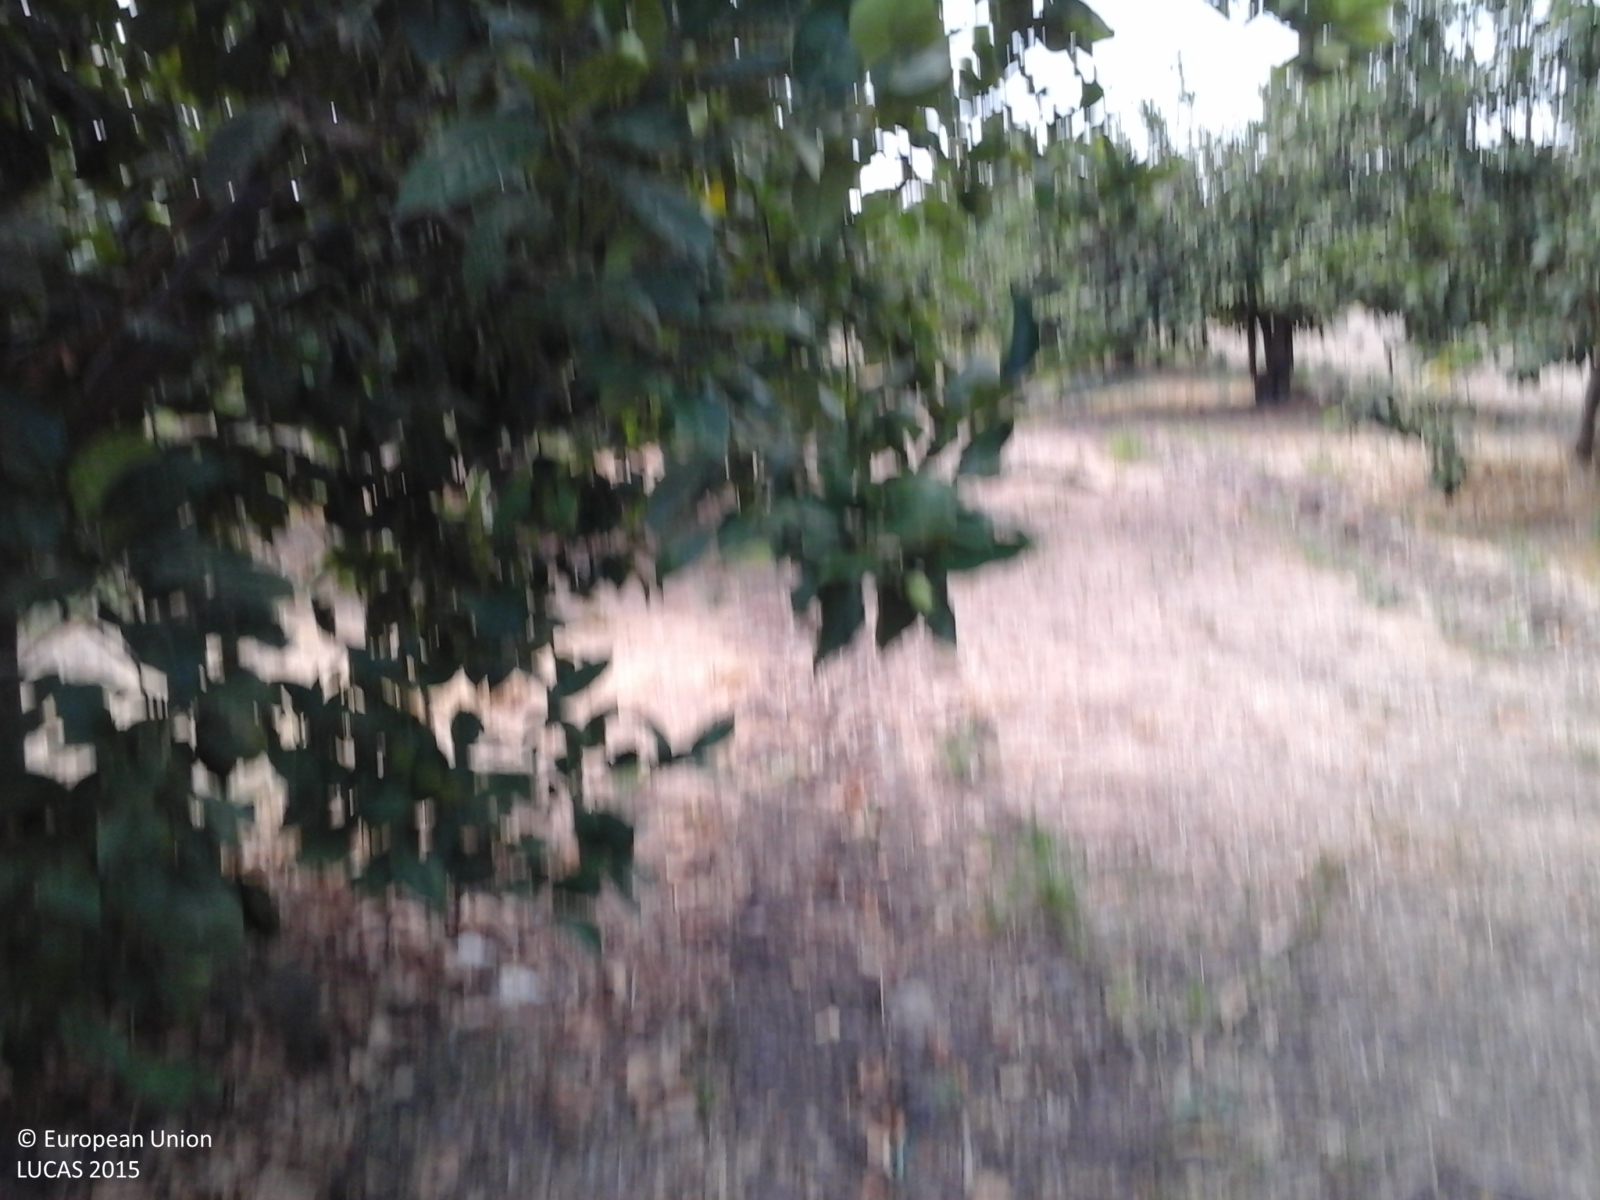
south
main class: Cropland
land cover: Oranges
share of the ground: > 75 %
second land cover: Spontaneously vegetated surfaces
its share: > 75 %
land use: Agriculture (excluding fallow land and kitchen gardens)
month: August
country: IT
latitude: 37.2953
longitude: 14.8708
